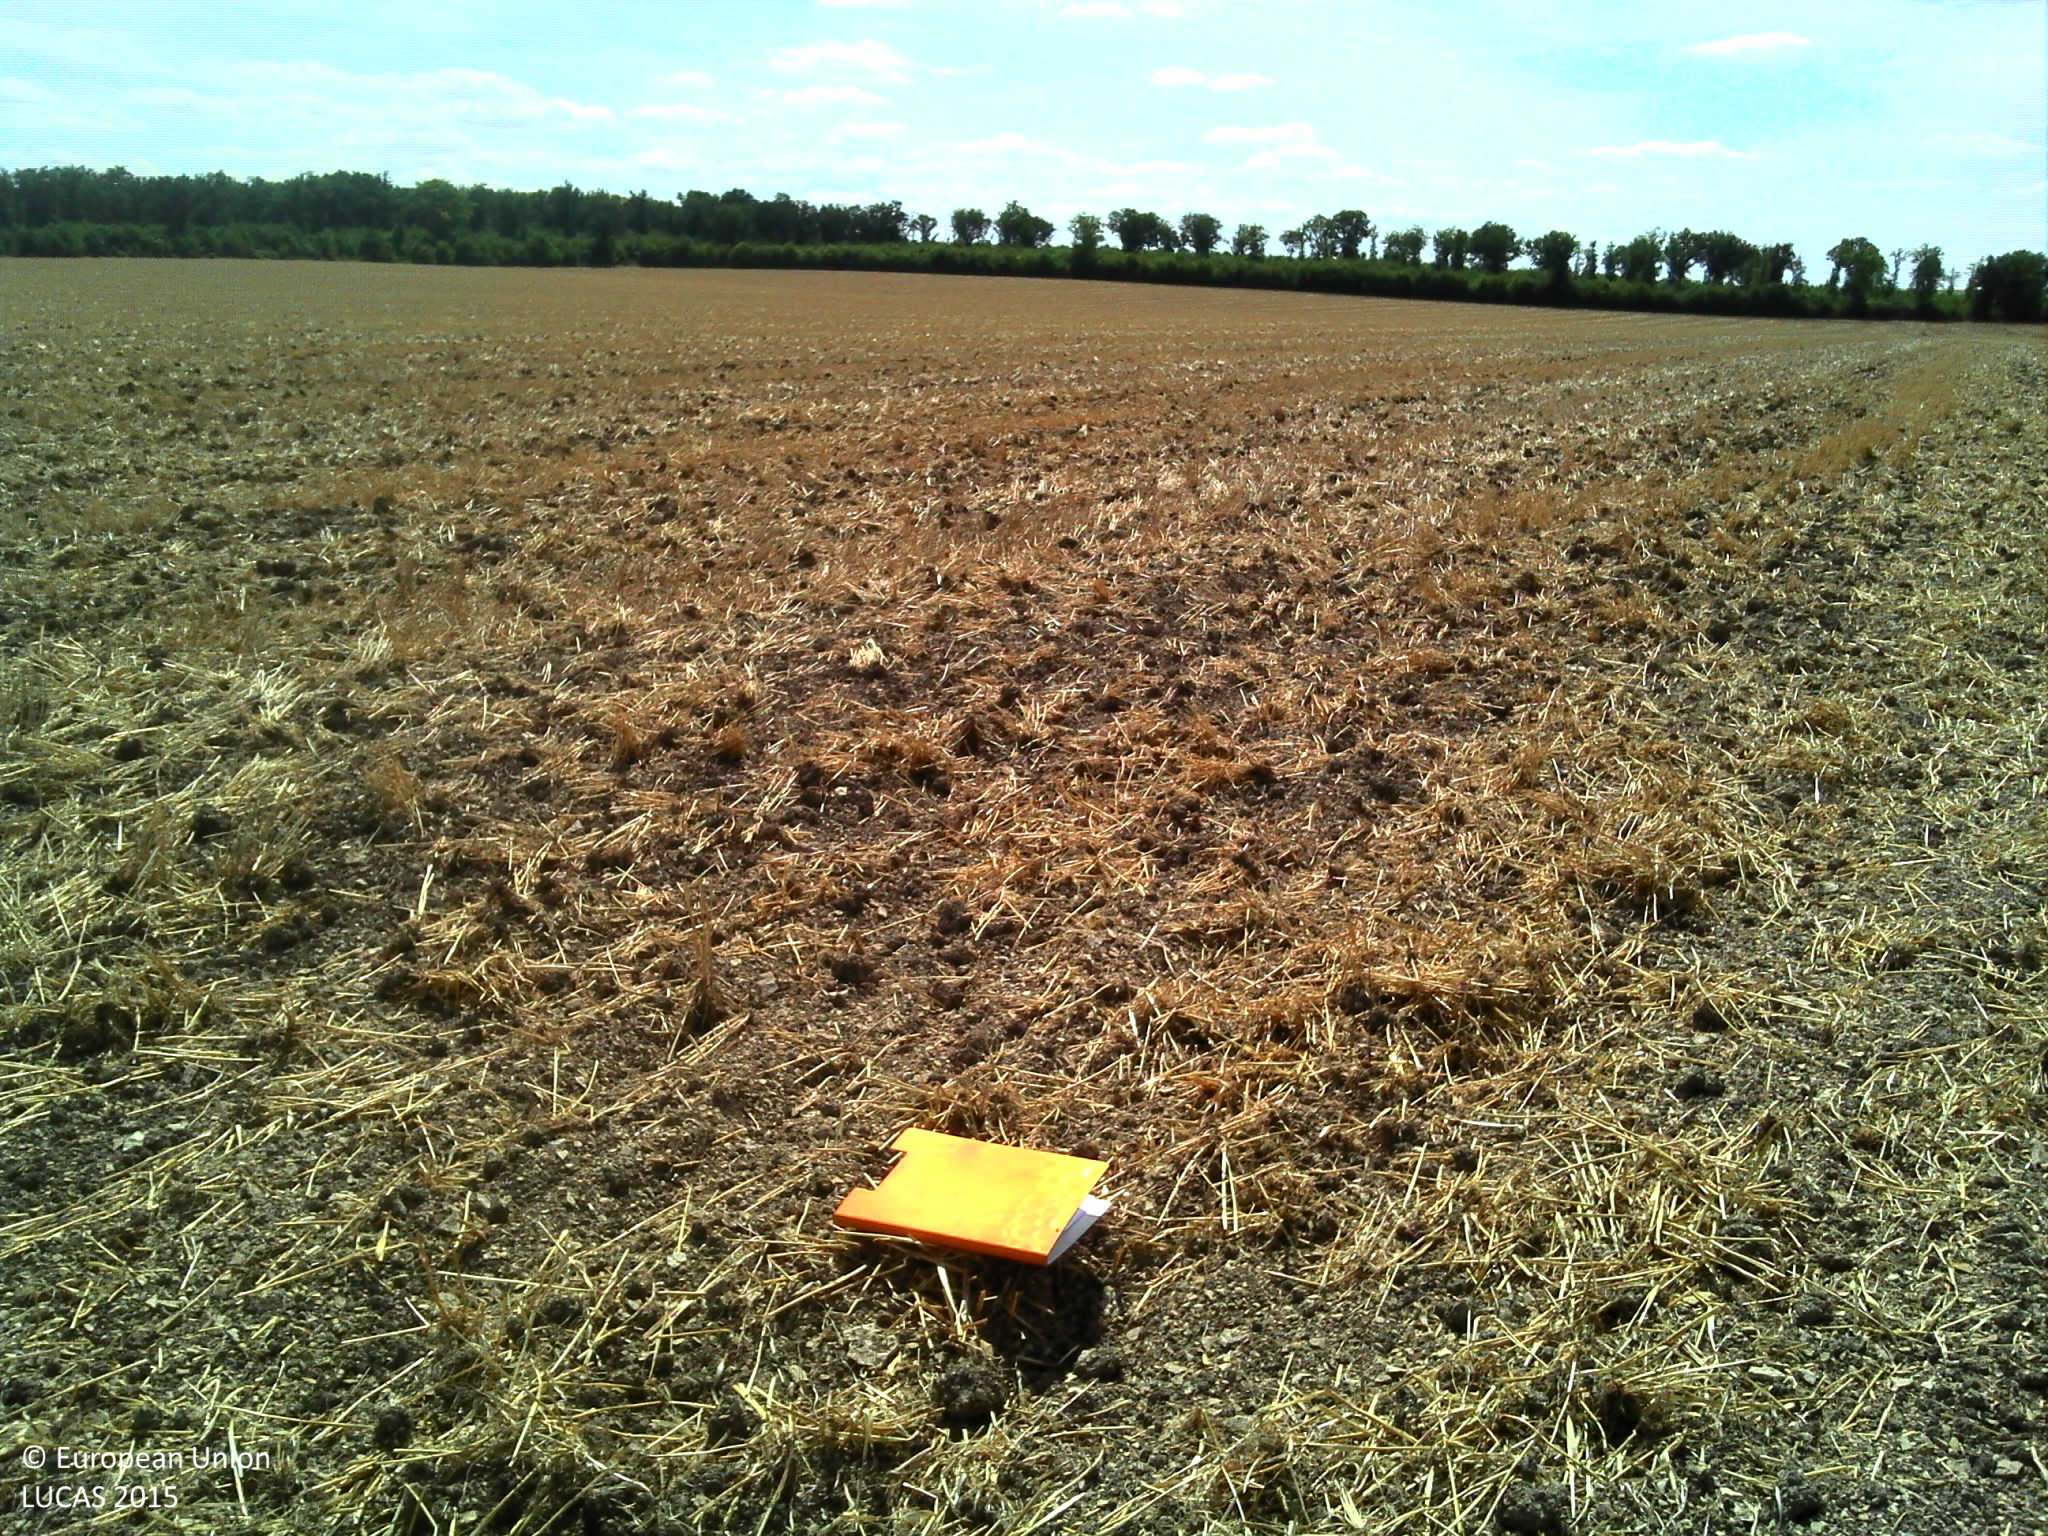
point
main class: Cropland
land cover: Barley
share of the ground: > 75 %
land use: Agriculture (excluding fallow land and kitchen gardens)
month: July
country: FR
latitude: 47.0183
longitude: 2.1112
